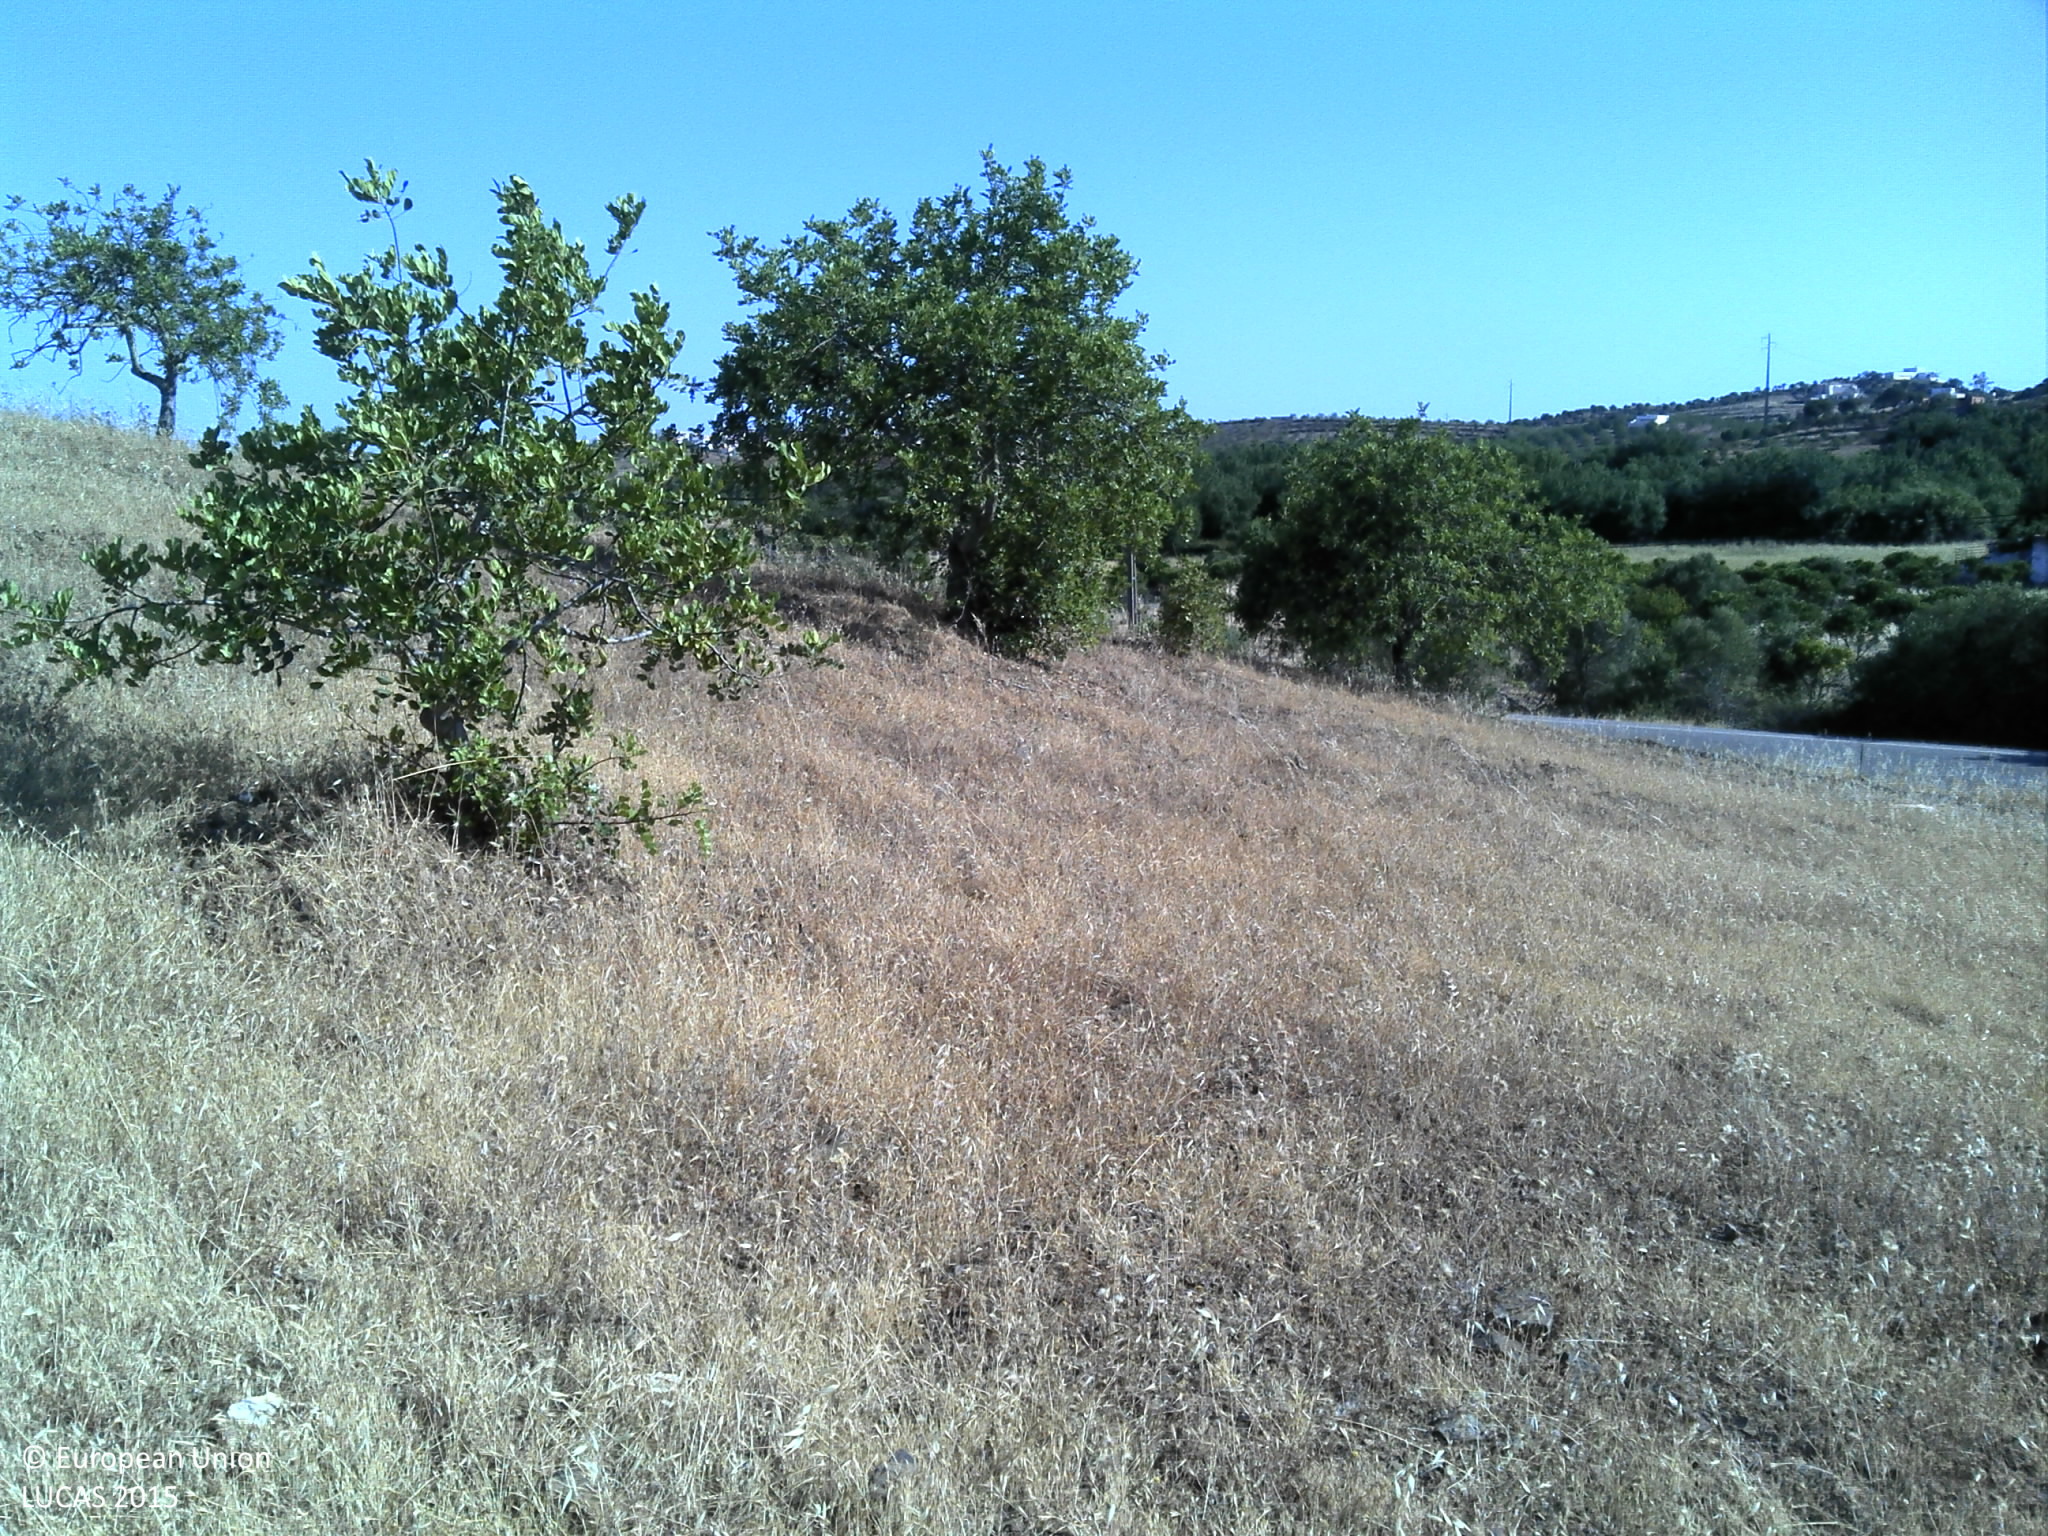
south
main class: Cropland
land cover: Permanent industrial crops
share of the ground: 25 - 50 %
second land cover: Spontaneously vegetated surfaces
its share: > 75 %
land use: Agriculture (excluding fallow land and kitchen gardens)
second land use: Other primary production
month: May
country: PT
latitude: 37.2240
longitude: -7.4833
